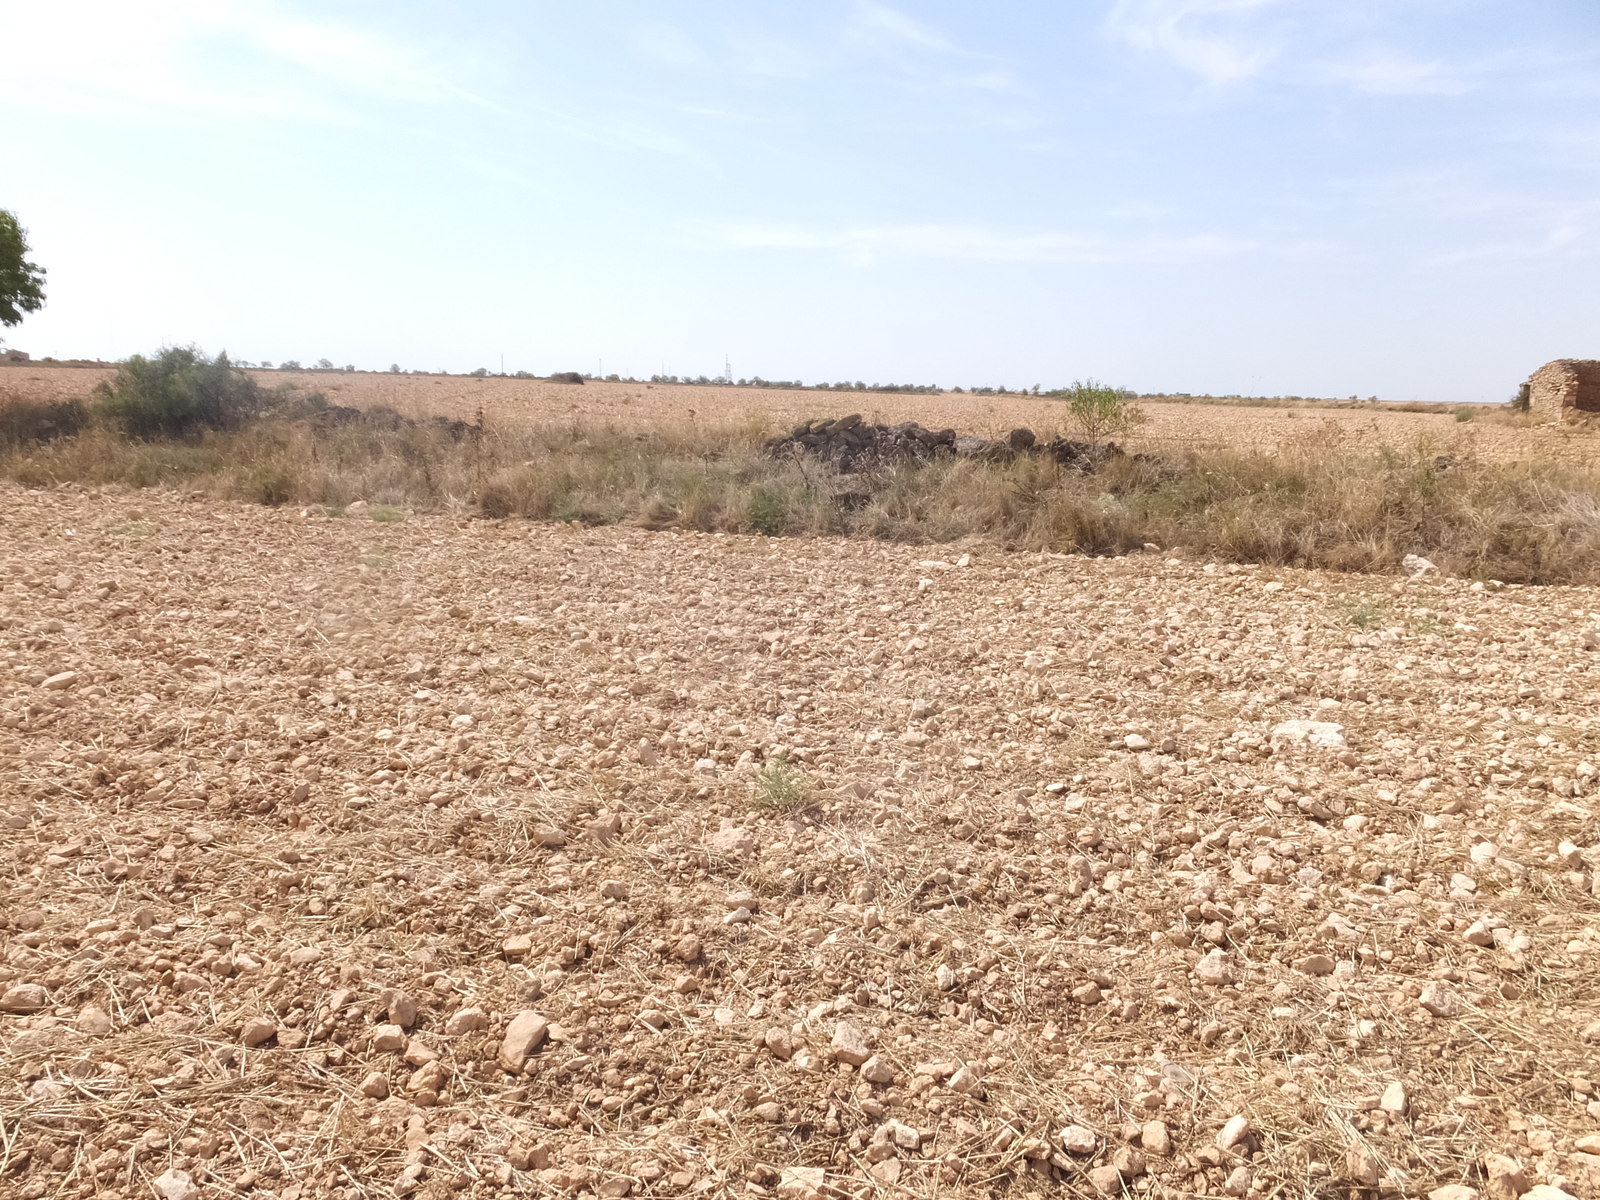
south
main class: Cropland
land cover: Common wheat
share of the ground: < 10 %
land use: Agriculture (excluding fallow land and kitchen gardens)
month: August
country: ES
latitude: 41.5296
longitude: 0.2668
